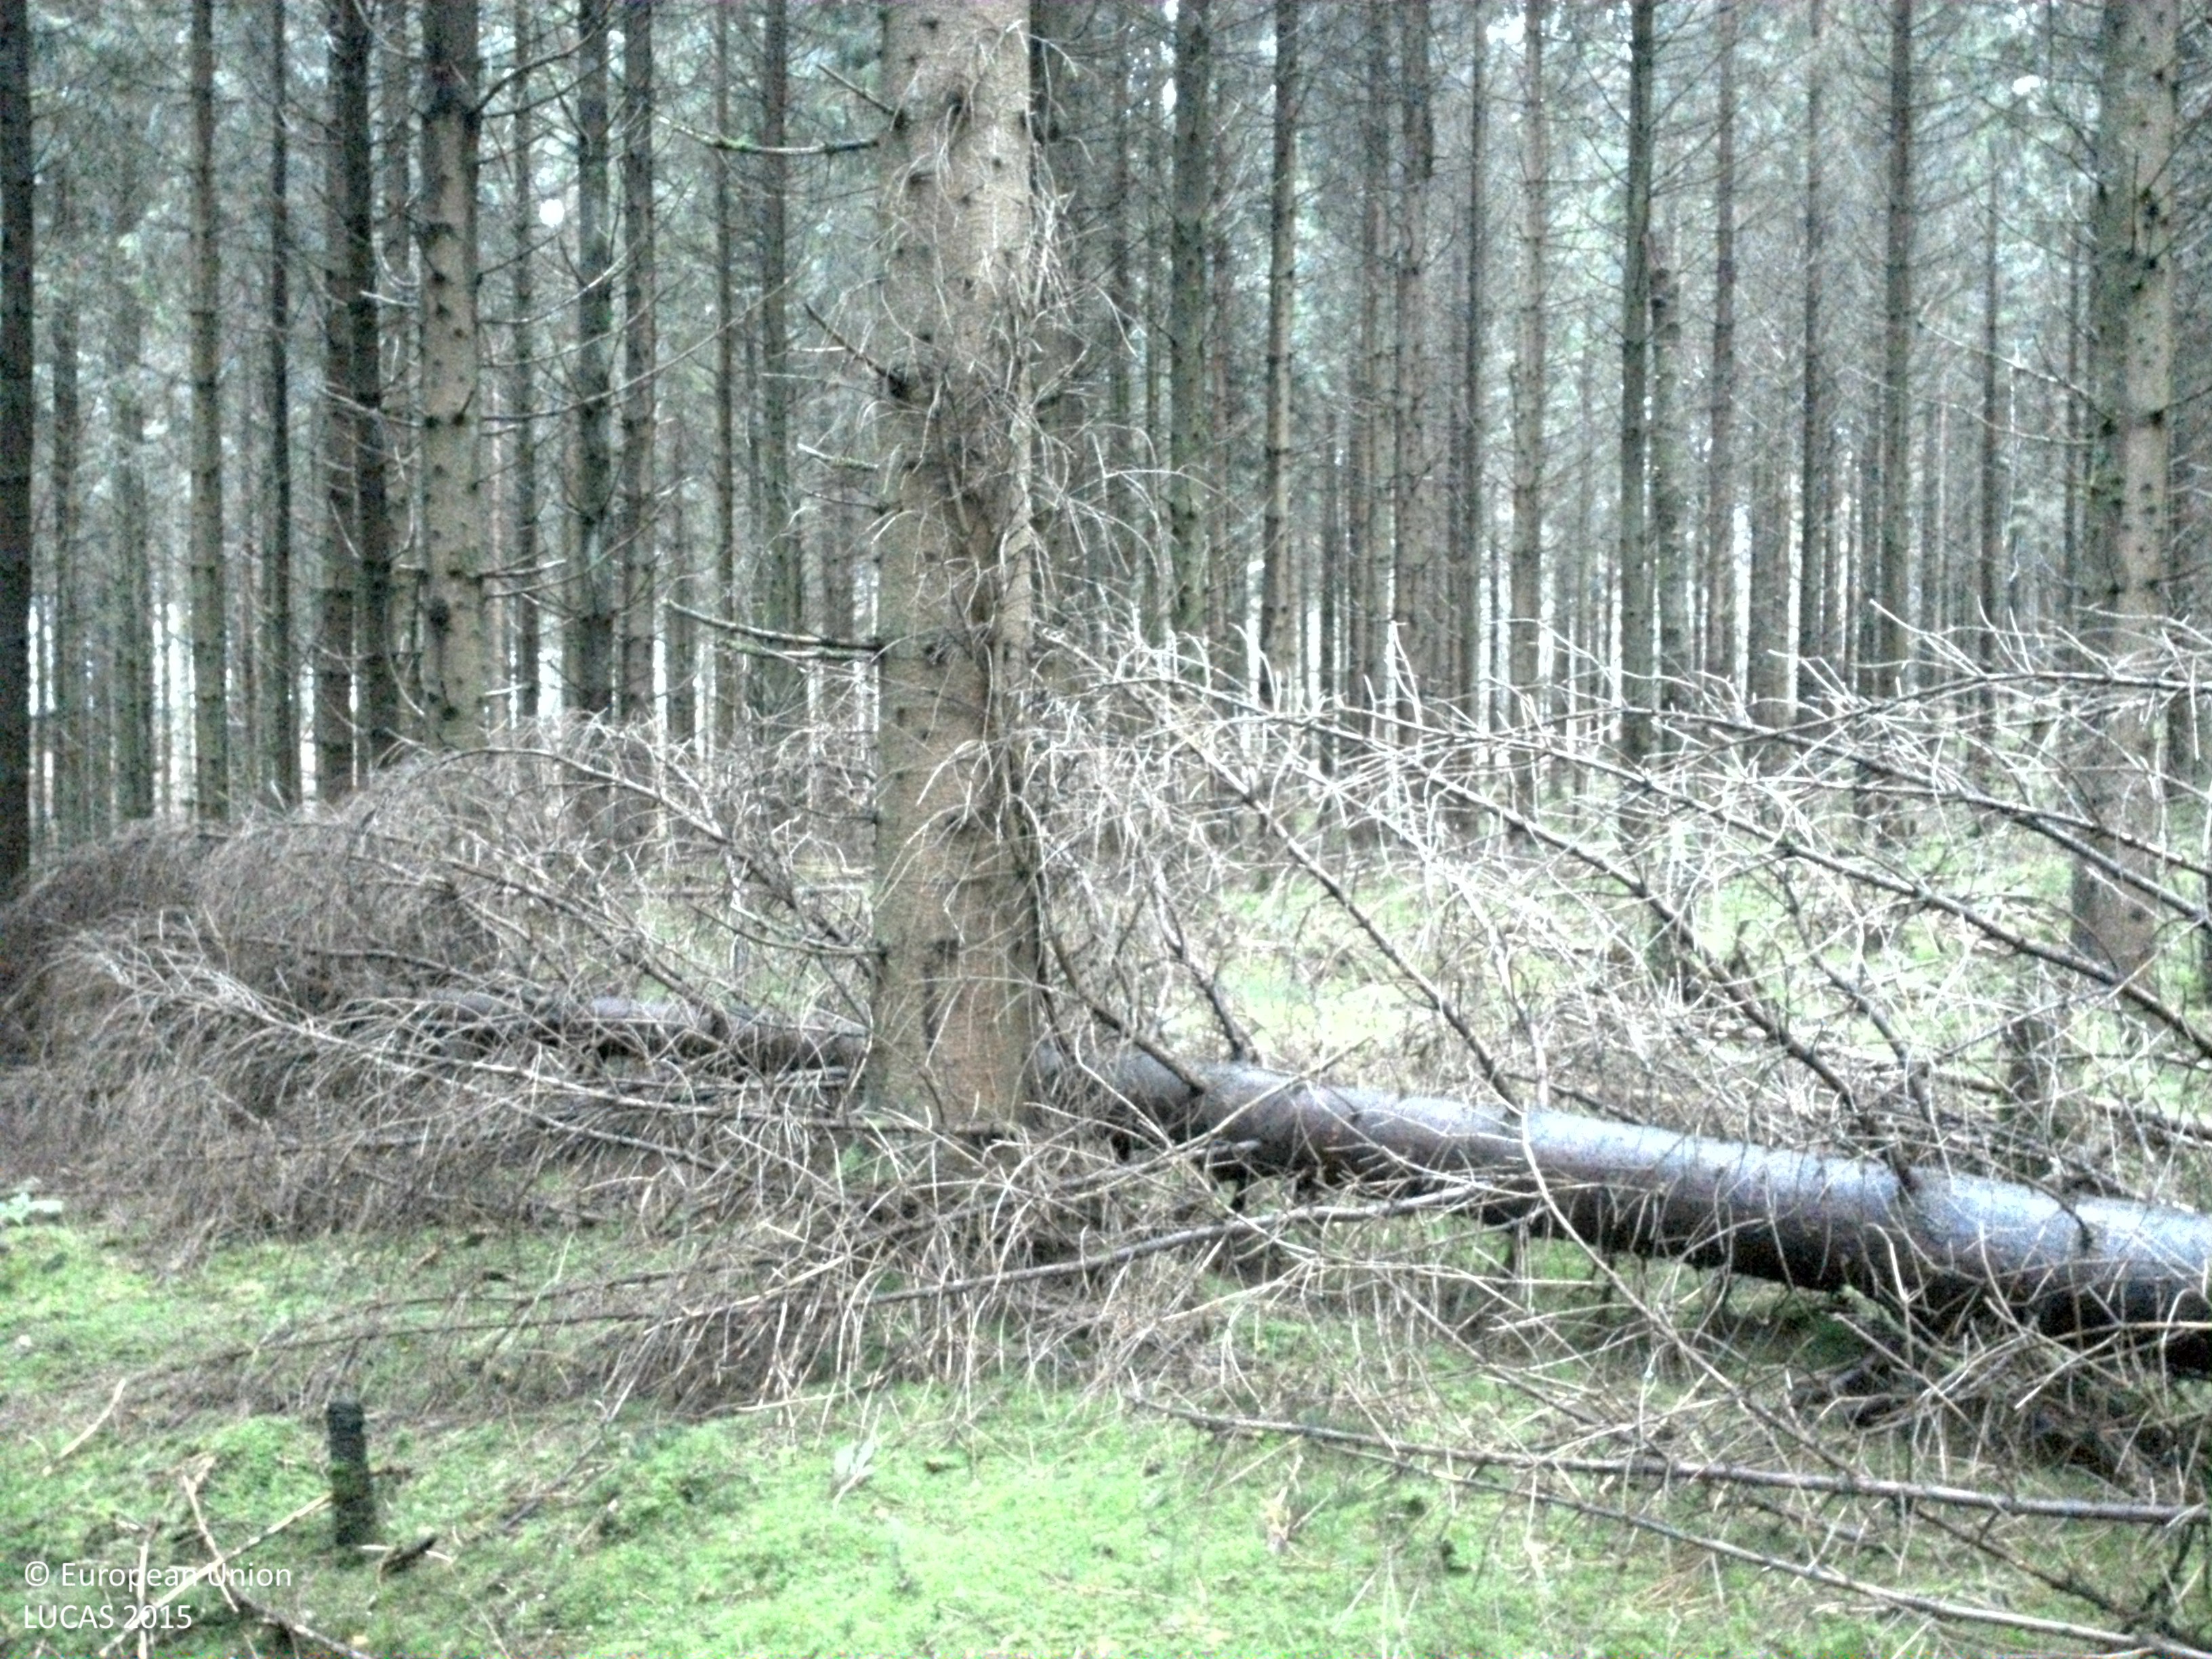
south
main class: Woodland
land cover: Spruce dominated coniferous woodland
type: hemiboreal forest and nemoral coniferous forest and mixed broadleaved-coniferous forest
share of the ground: > 75 %
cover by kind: coniferous forest trees 85 %, lichens and mosses 10 %, herbaceous plants 5 %
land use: Forestry
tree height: > 5 m
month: November
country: SE
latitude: 56.2385
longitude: 13.1758
